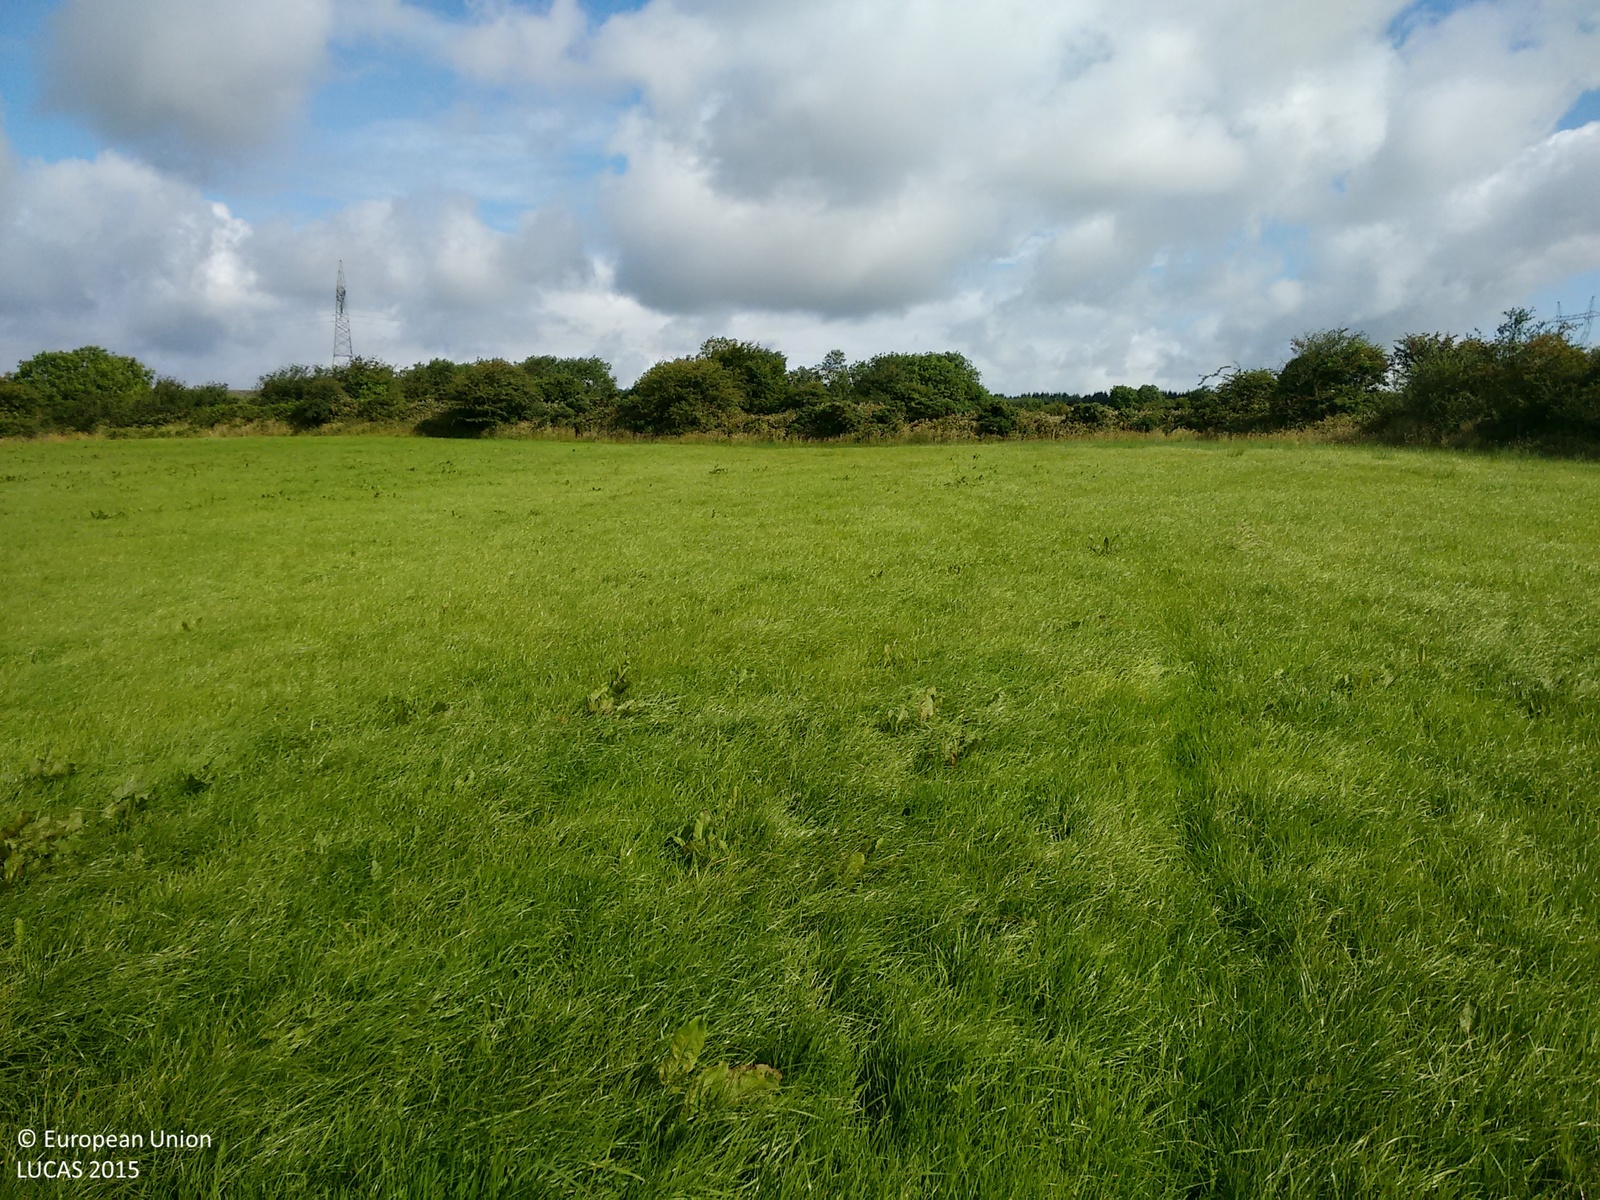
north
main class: Grassland
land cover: Grassland without tree/shrub cover
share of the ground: > 75 %
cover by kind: herbaceous plants 100 %
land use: Agriculture (excluding fallow land and kitchen gardens)
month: July
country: IE
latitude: 52.8106
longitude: -8.3625
